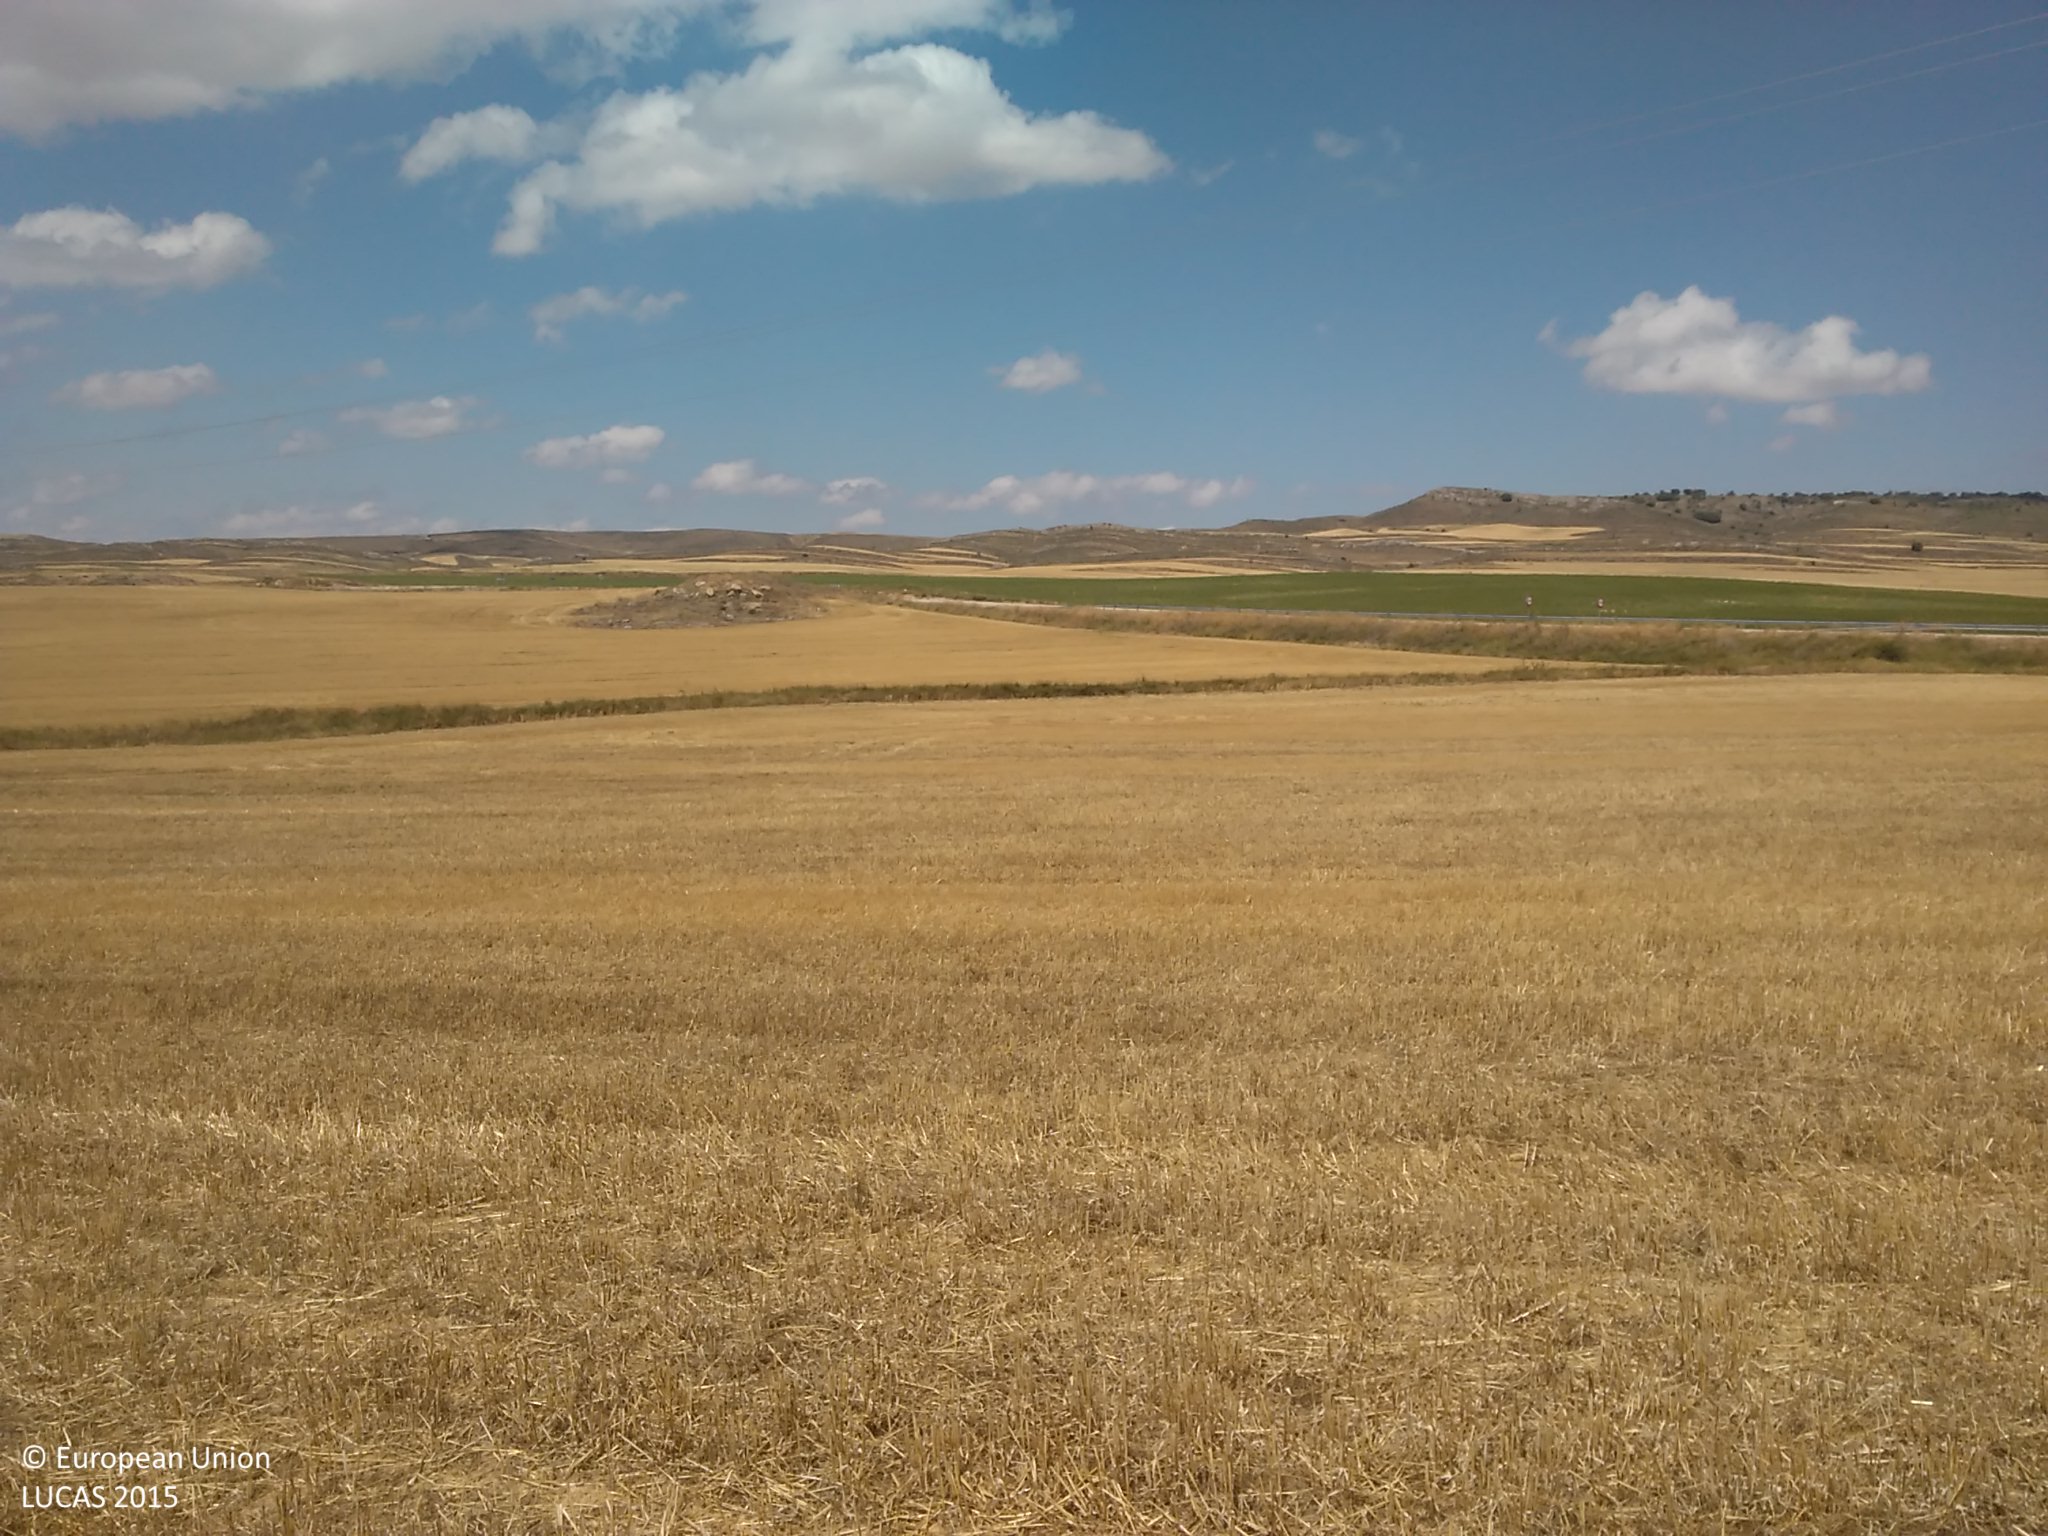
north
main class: Cropland
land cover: Barley
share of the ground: < 10 %
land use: Agriculture (excluding fallow land and kitchen gardens)
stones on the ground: < 10 %
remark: Harvested field
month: July
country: ES
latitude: 41.6019
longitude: -2.2117
